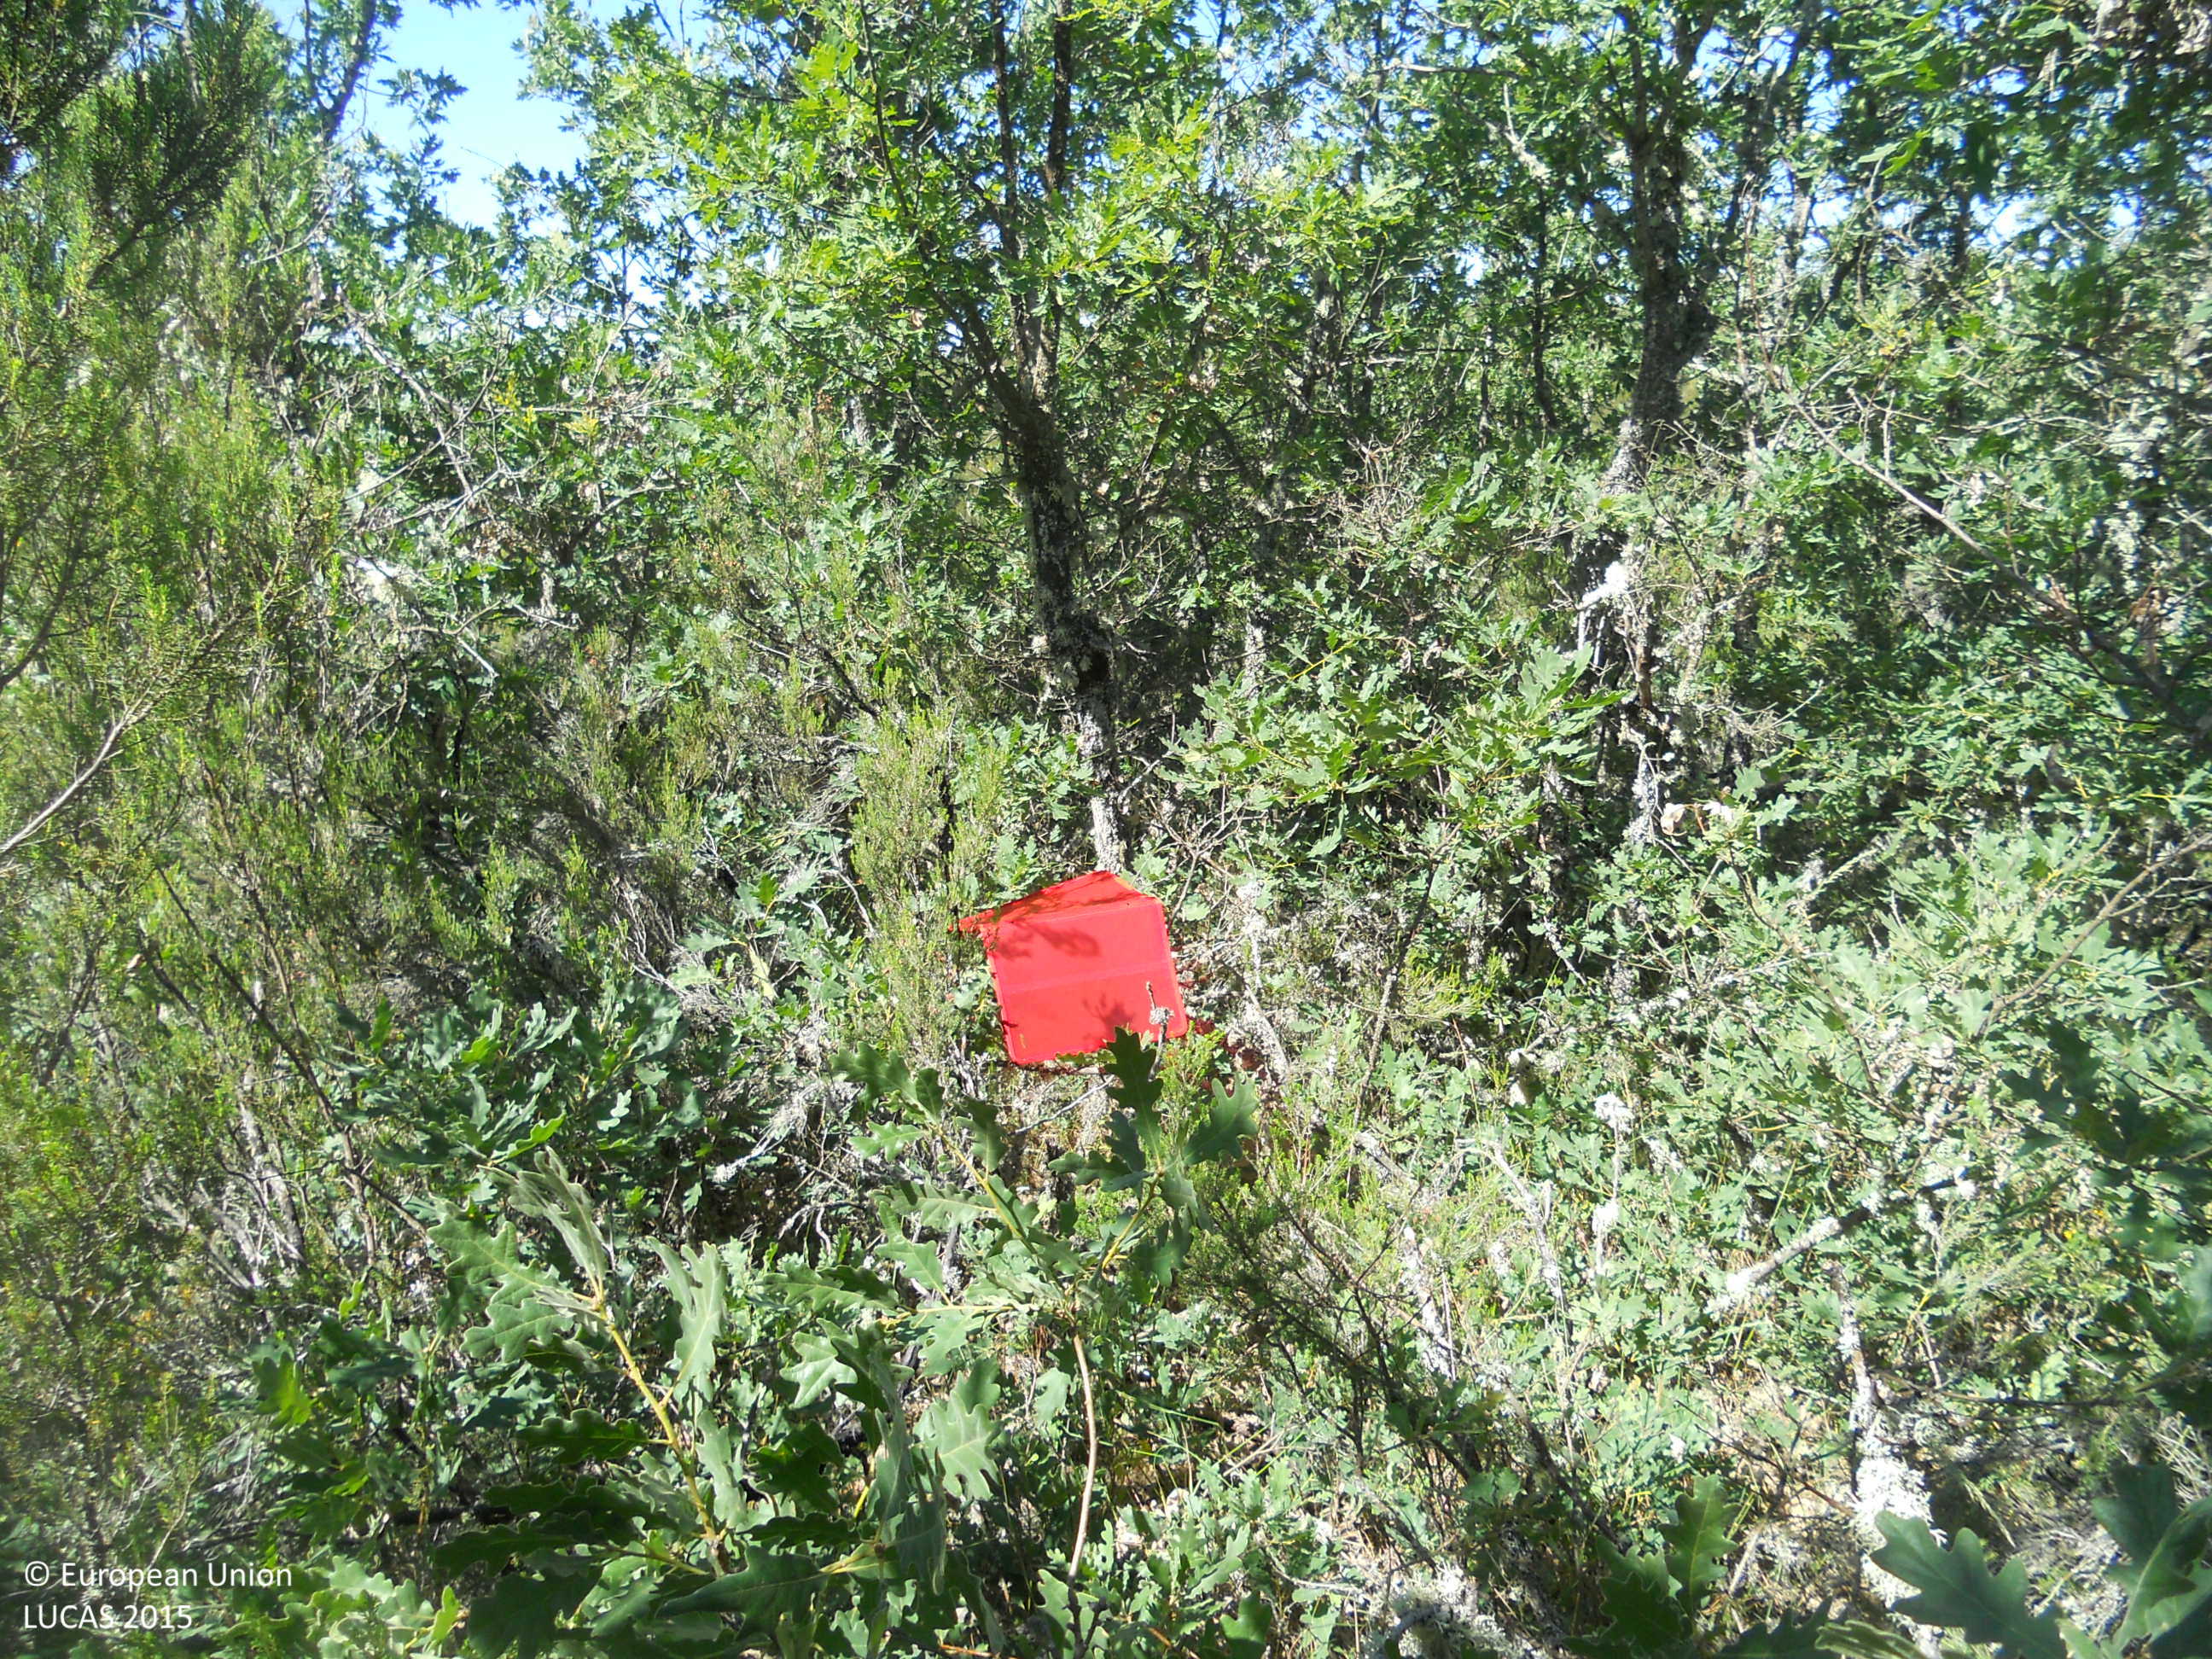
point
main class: Woodland
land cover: Broadleaved woodland
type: acidophilous oak and oak-birch forest
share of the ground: 50 - 75 %
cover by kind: broadleaved forest trees 70 %, shrubs 25 %, herbaceous plants 5 %
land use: Forestry
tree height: > 5 m
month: June
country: ES
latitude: 42.6194
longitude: -4.9467
